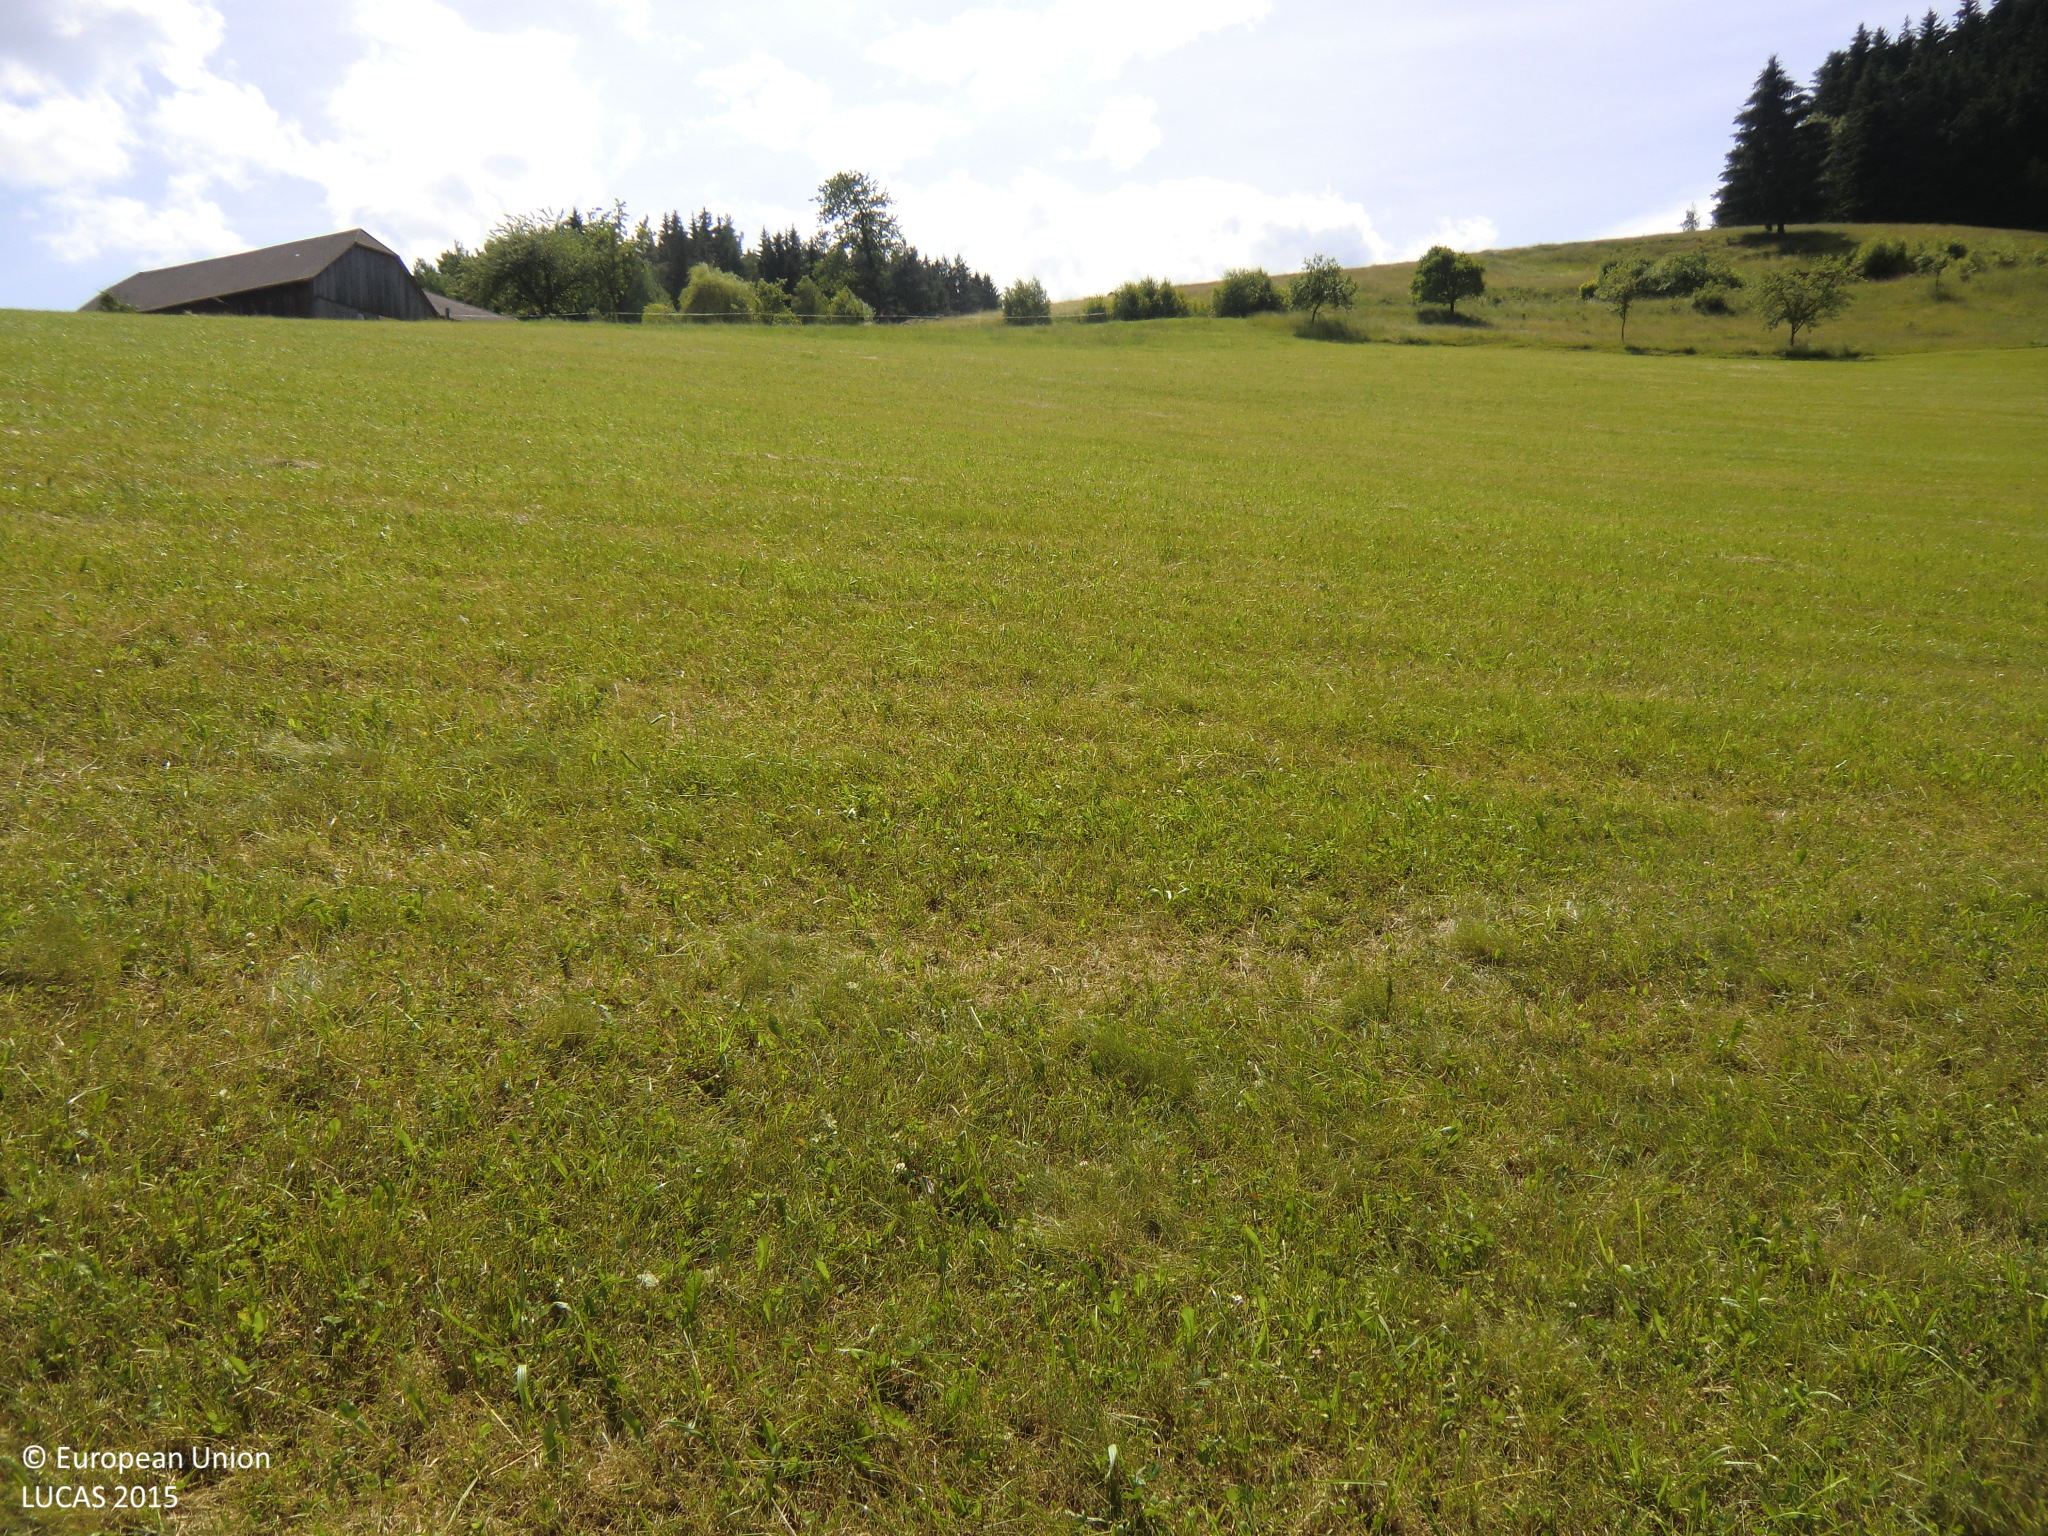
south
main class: Grassland
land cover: Grassland without tree/shrub cover
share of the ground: > 75 %
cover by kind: herbaceous plants 100 %
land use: Agriculture (excluding fallow land and kitchen gardens)
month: June
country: AT
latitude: 48.5224
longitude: 15.0520
